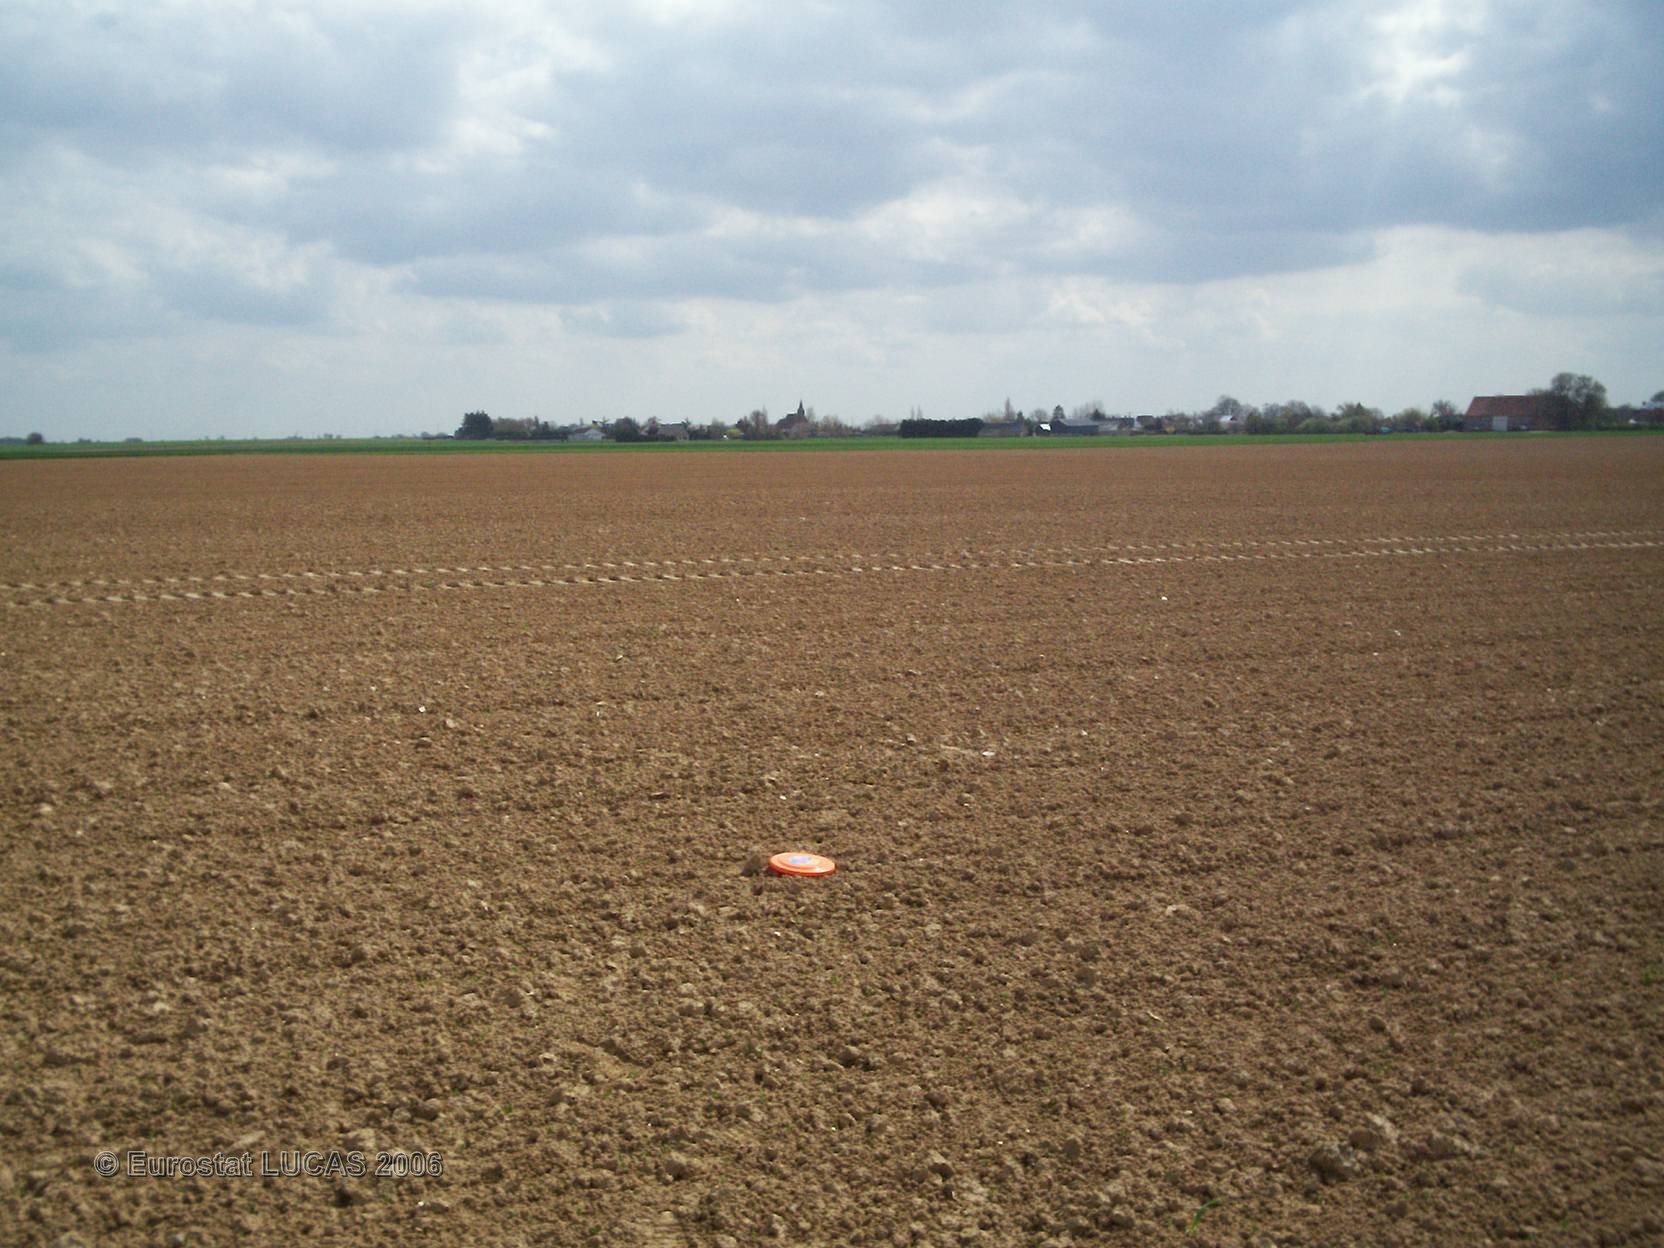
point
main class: Cropland
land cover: Dry pulses
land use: Agriculture (excluding fallow land and kitchen gardens)
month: April
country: FR
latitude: 49.0865
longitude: 1.0097
